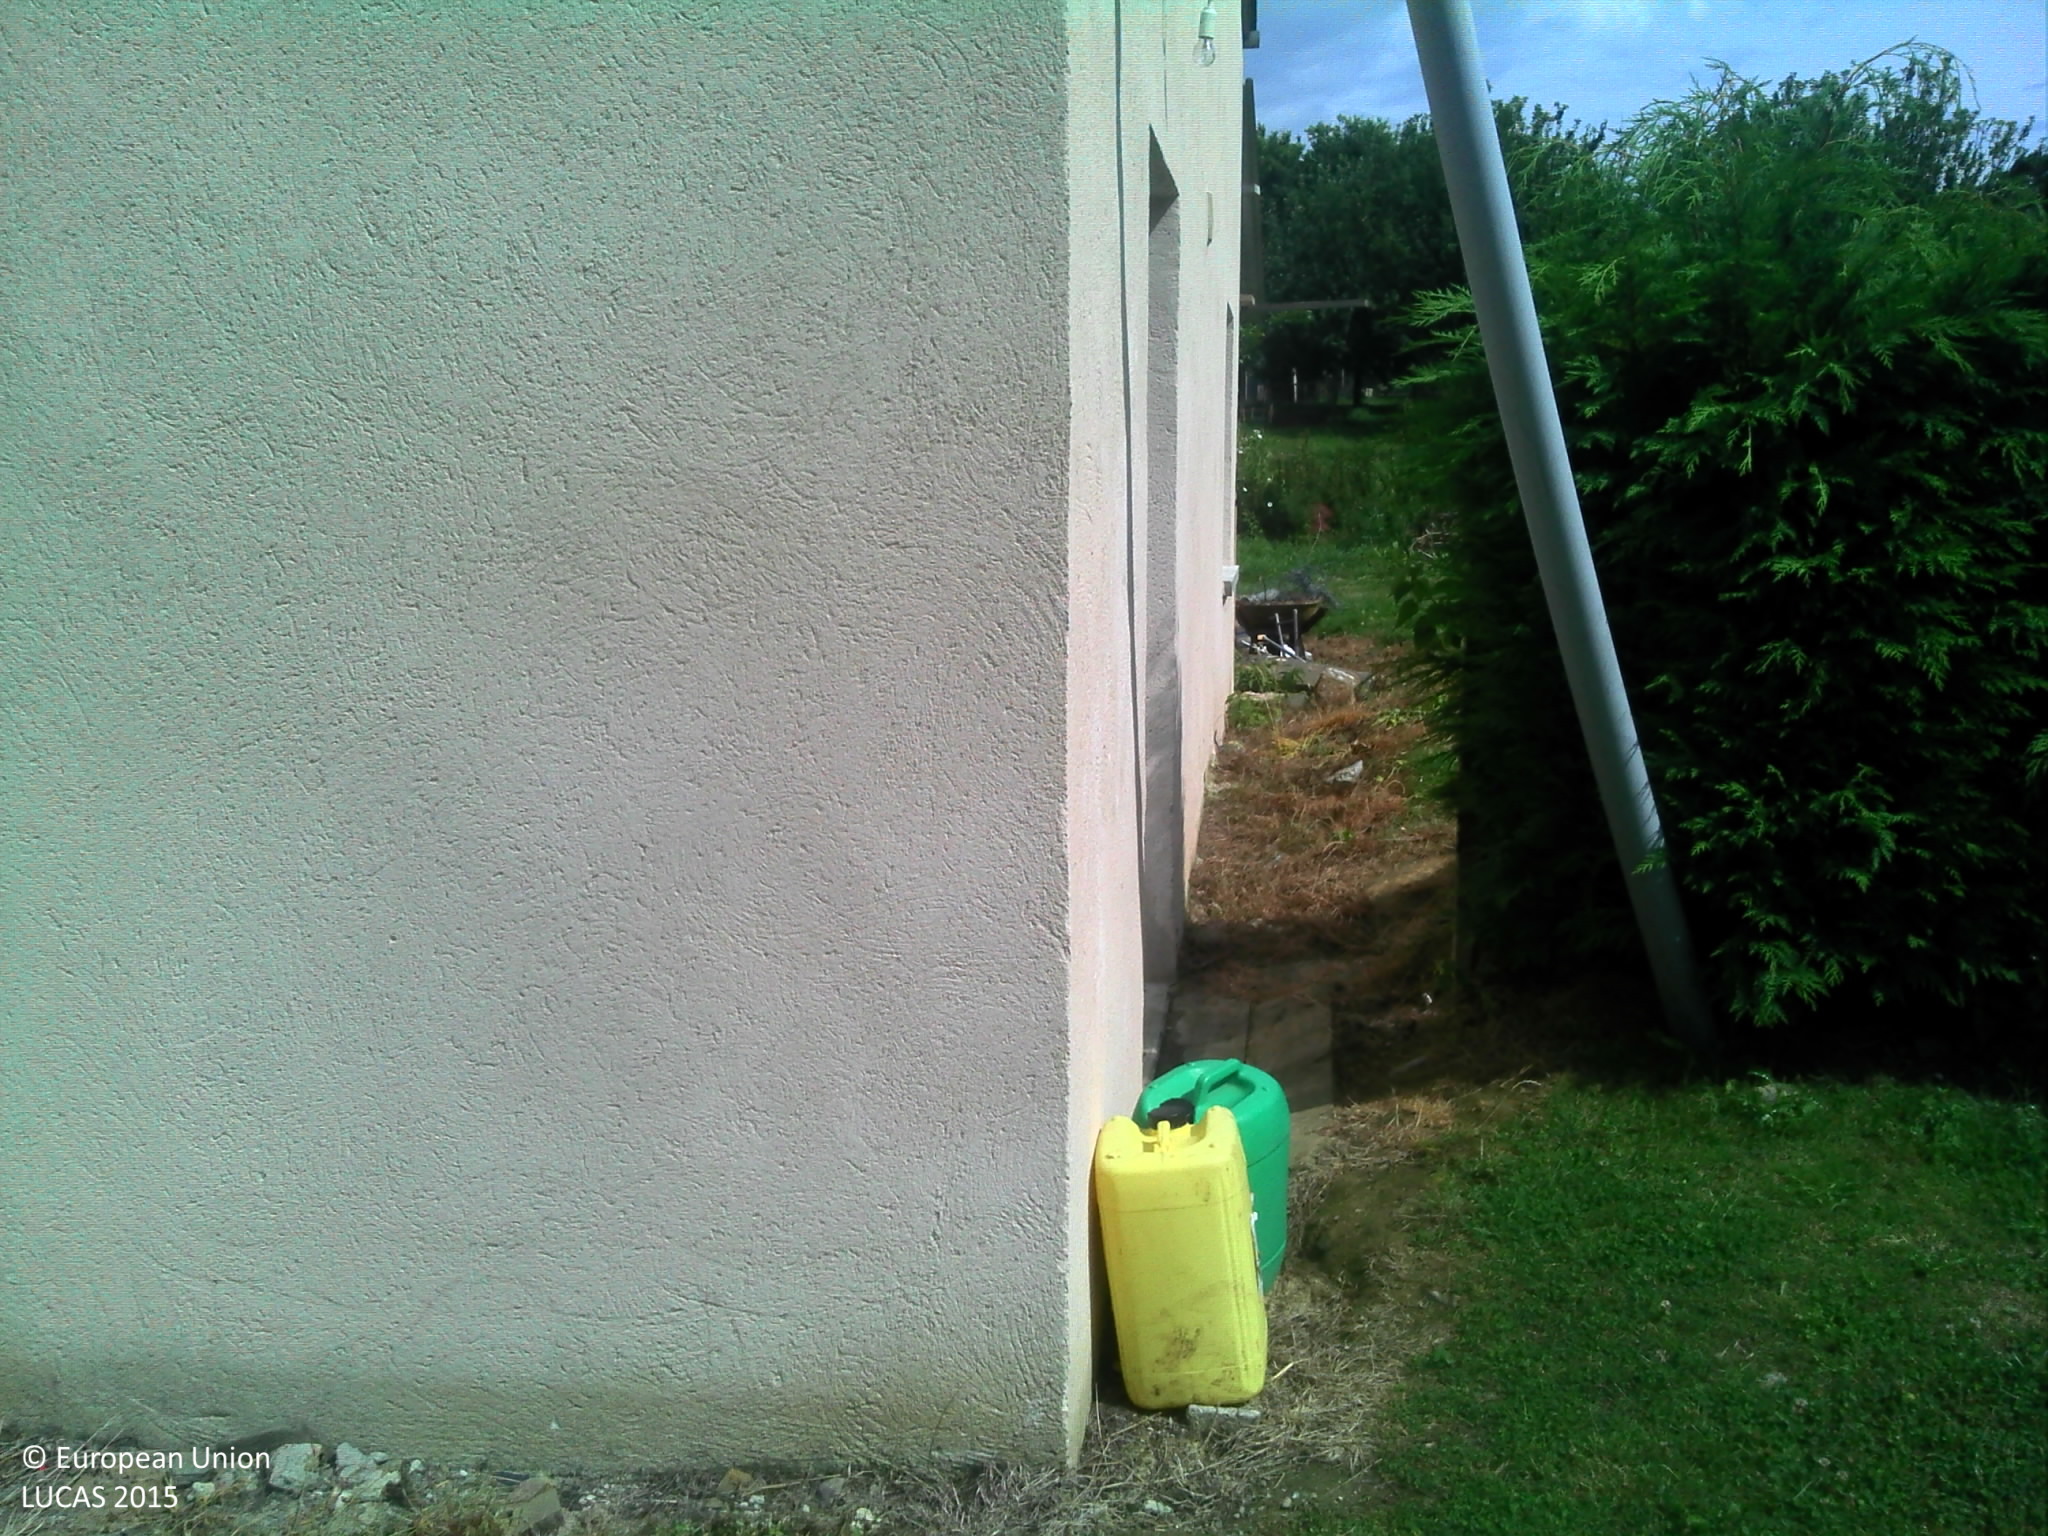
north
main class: Grassland
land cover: Grassland with sparse tree/shrub cover
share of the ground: > 75 %
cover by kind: herbaceous plants 95 %, broadleaved forest trees 5 %
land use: Residential
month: July
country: FR
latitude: 48.8093
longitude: -1.4169
